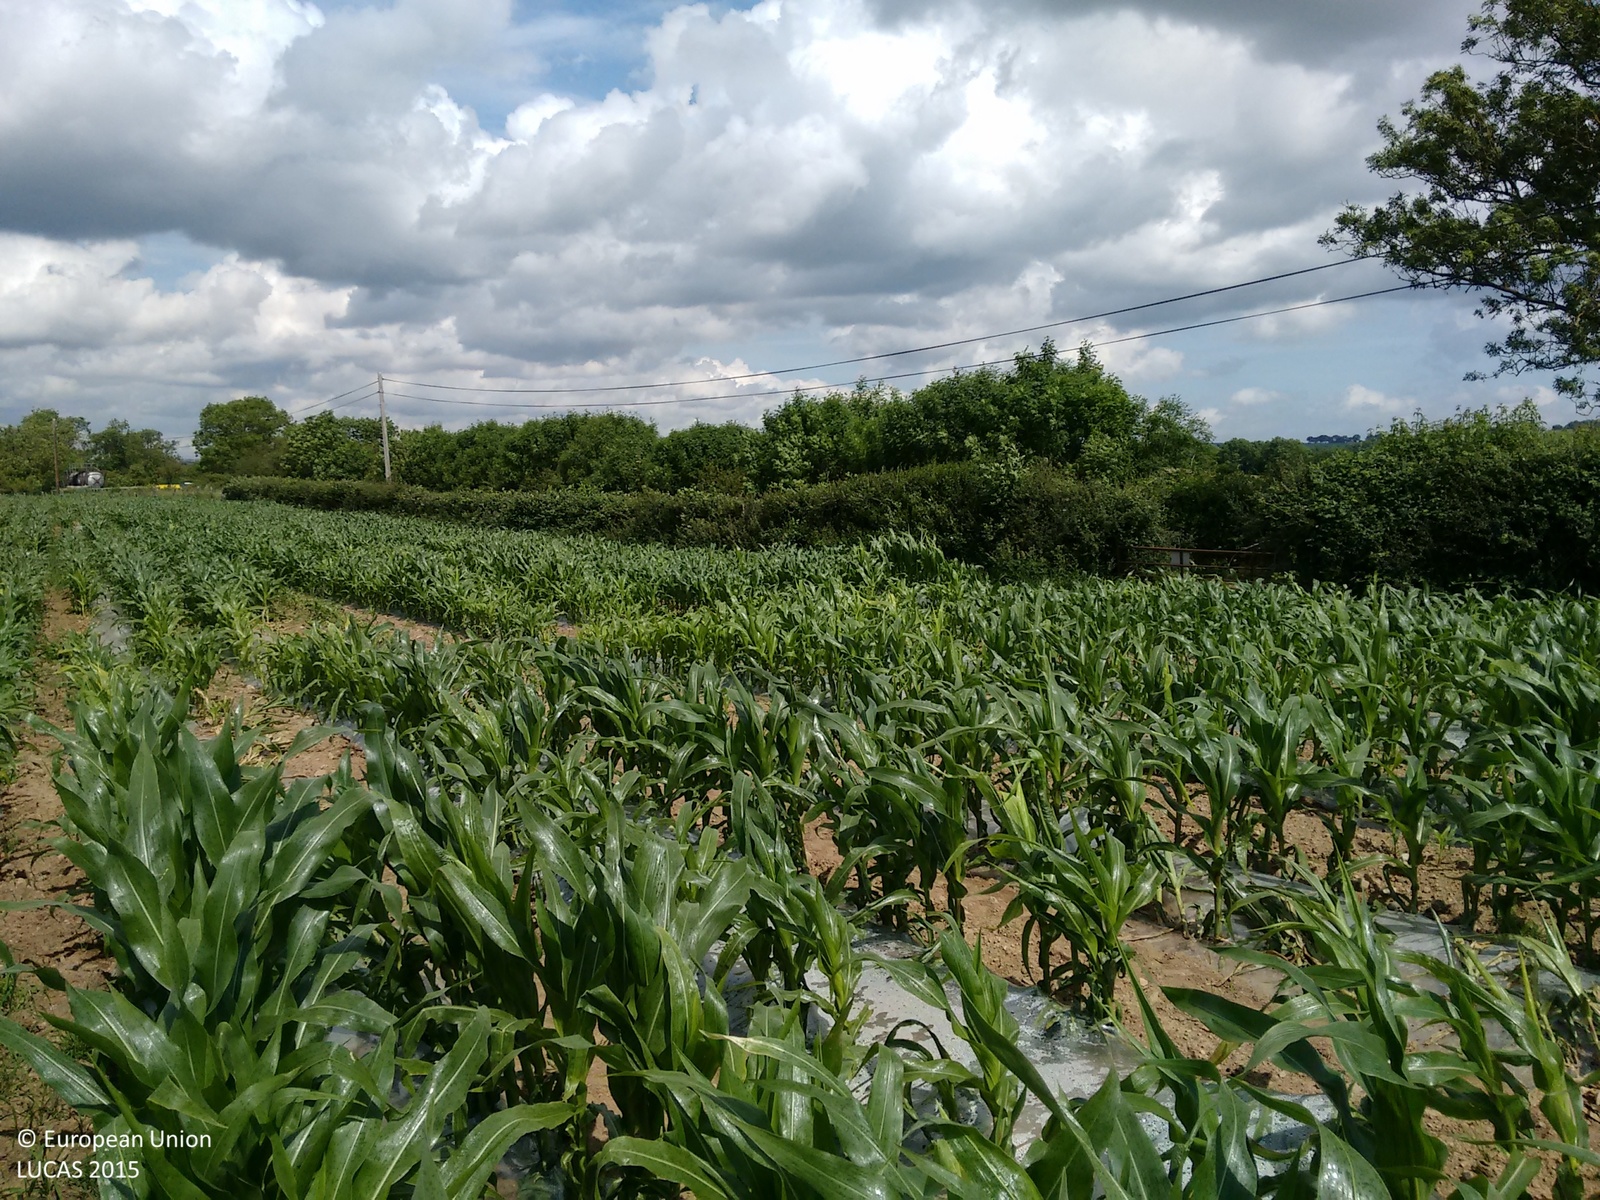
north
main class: Cropland
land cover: Maize
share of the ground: > 75 %
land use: Agriculture (excluding fallow land and kitchen gardens)
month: July
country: IE
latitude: 53.8073
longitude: -6.7308
